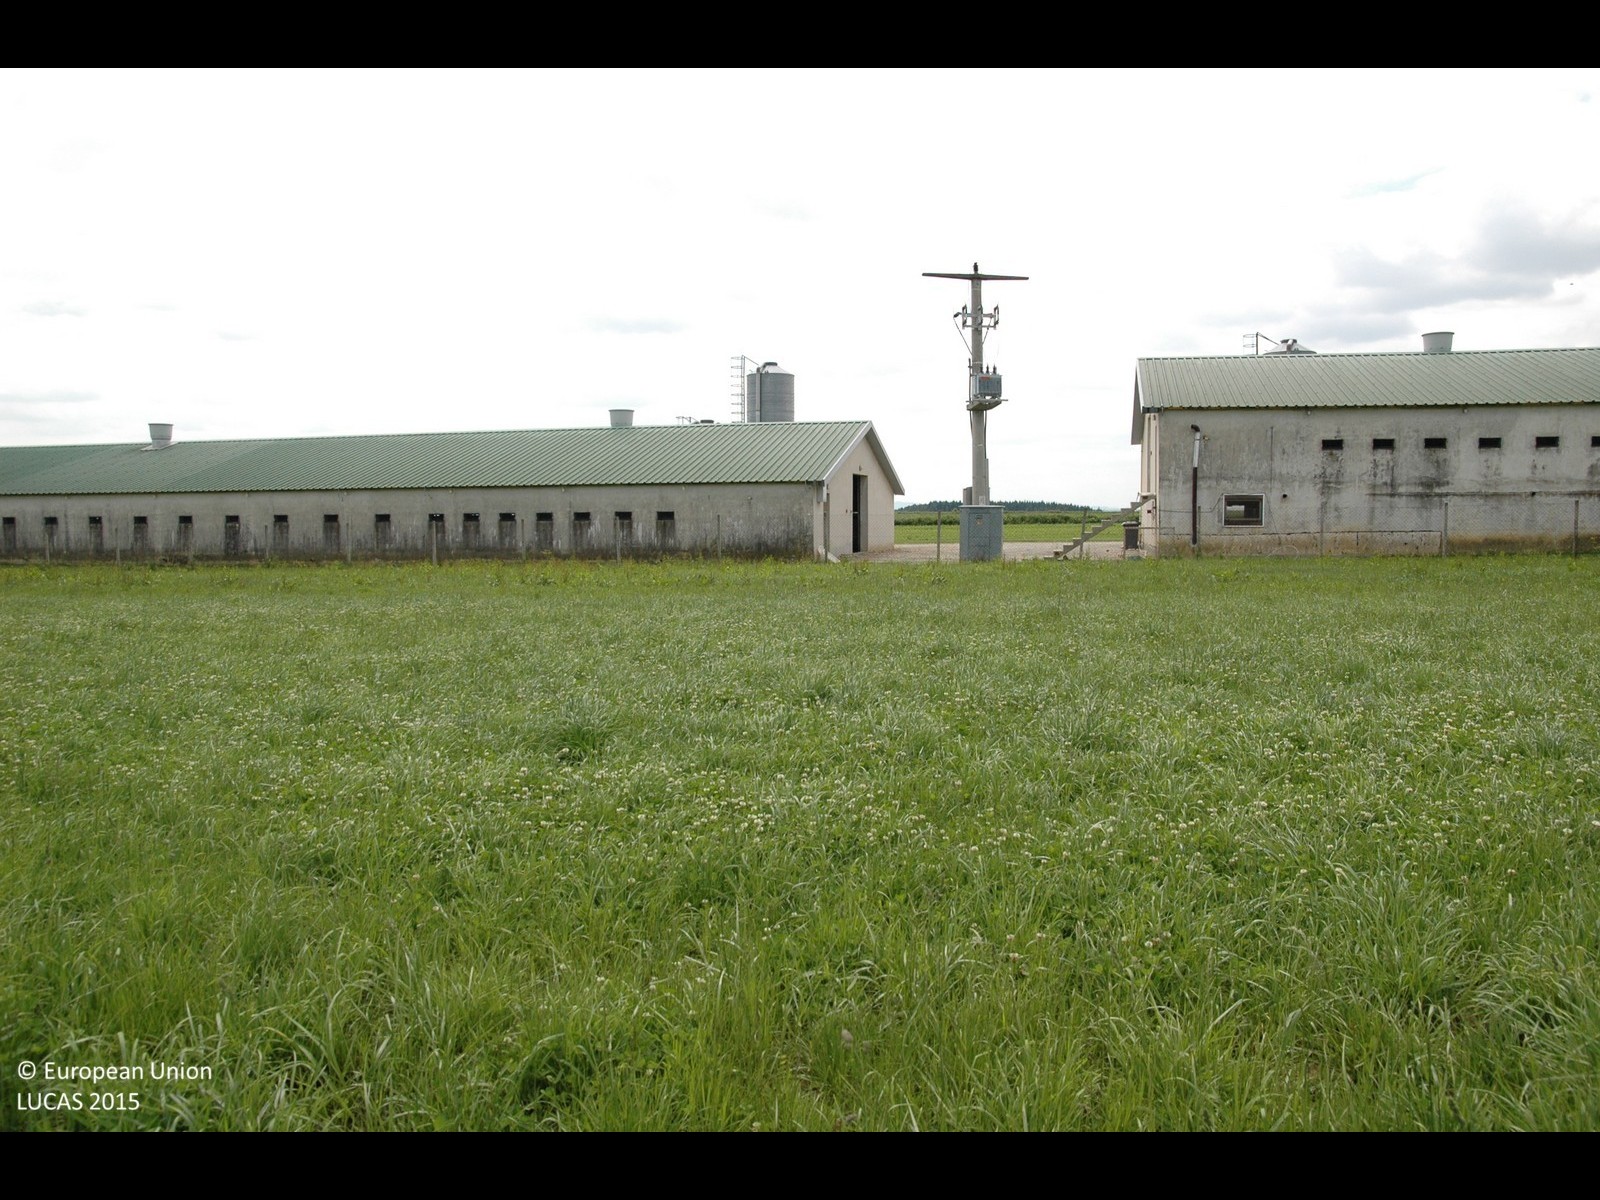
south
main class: Grassland
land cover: Grassland without tree/shrub cover
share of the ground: > 75 %
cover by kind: herbaceous plants 100 %
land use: Agriculture (excluding fallow land and kitchen gardens)
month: May
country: HR
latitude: 46.4280
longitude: 16.4422
